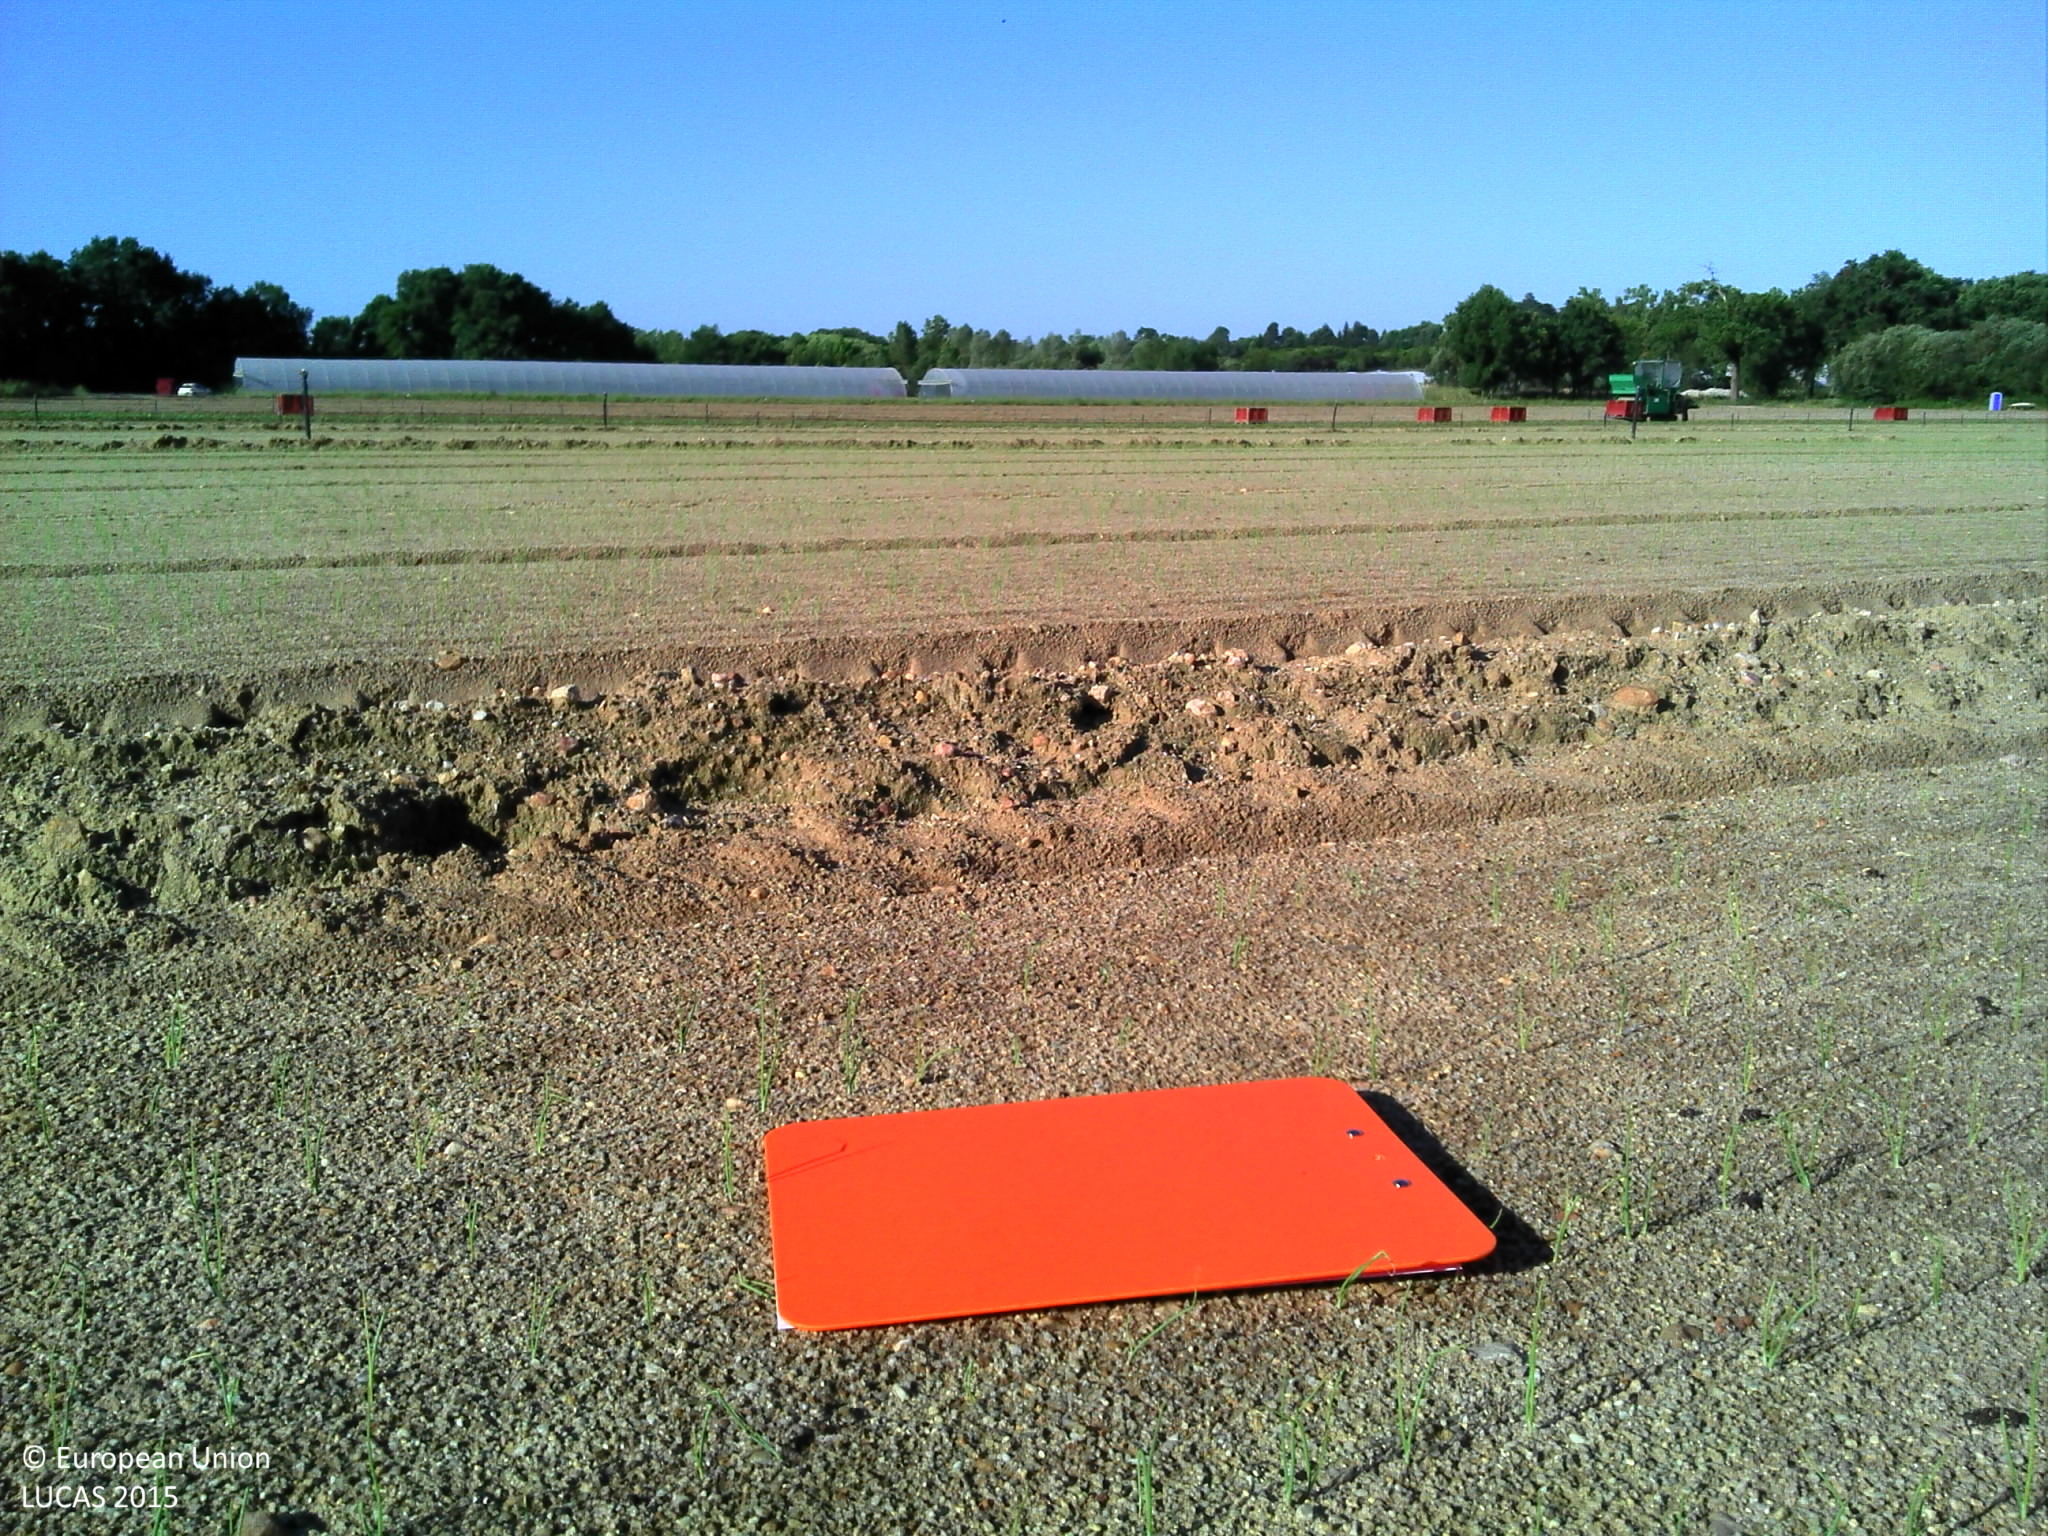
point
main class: Cropland
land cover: Other fresh vegetables
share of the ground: < 10 %
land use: Agriculture (excluding fallow land and kitchen gardens)
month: June
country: FR
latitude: 47.2972
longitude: -1.4540
